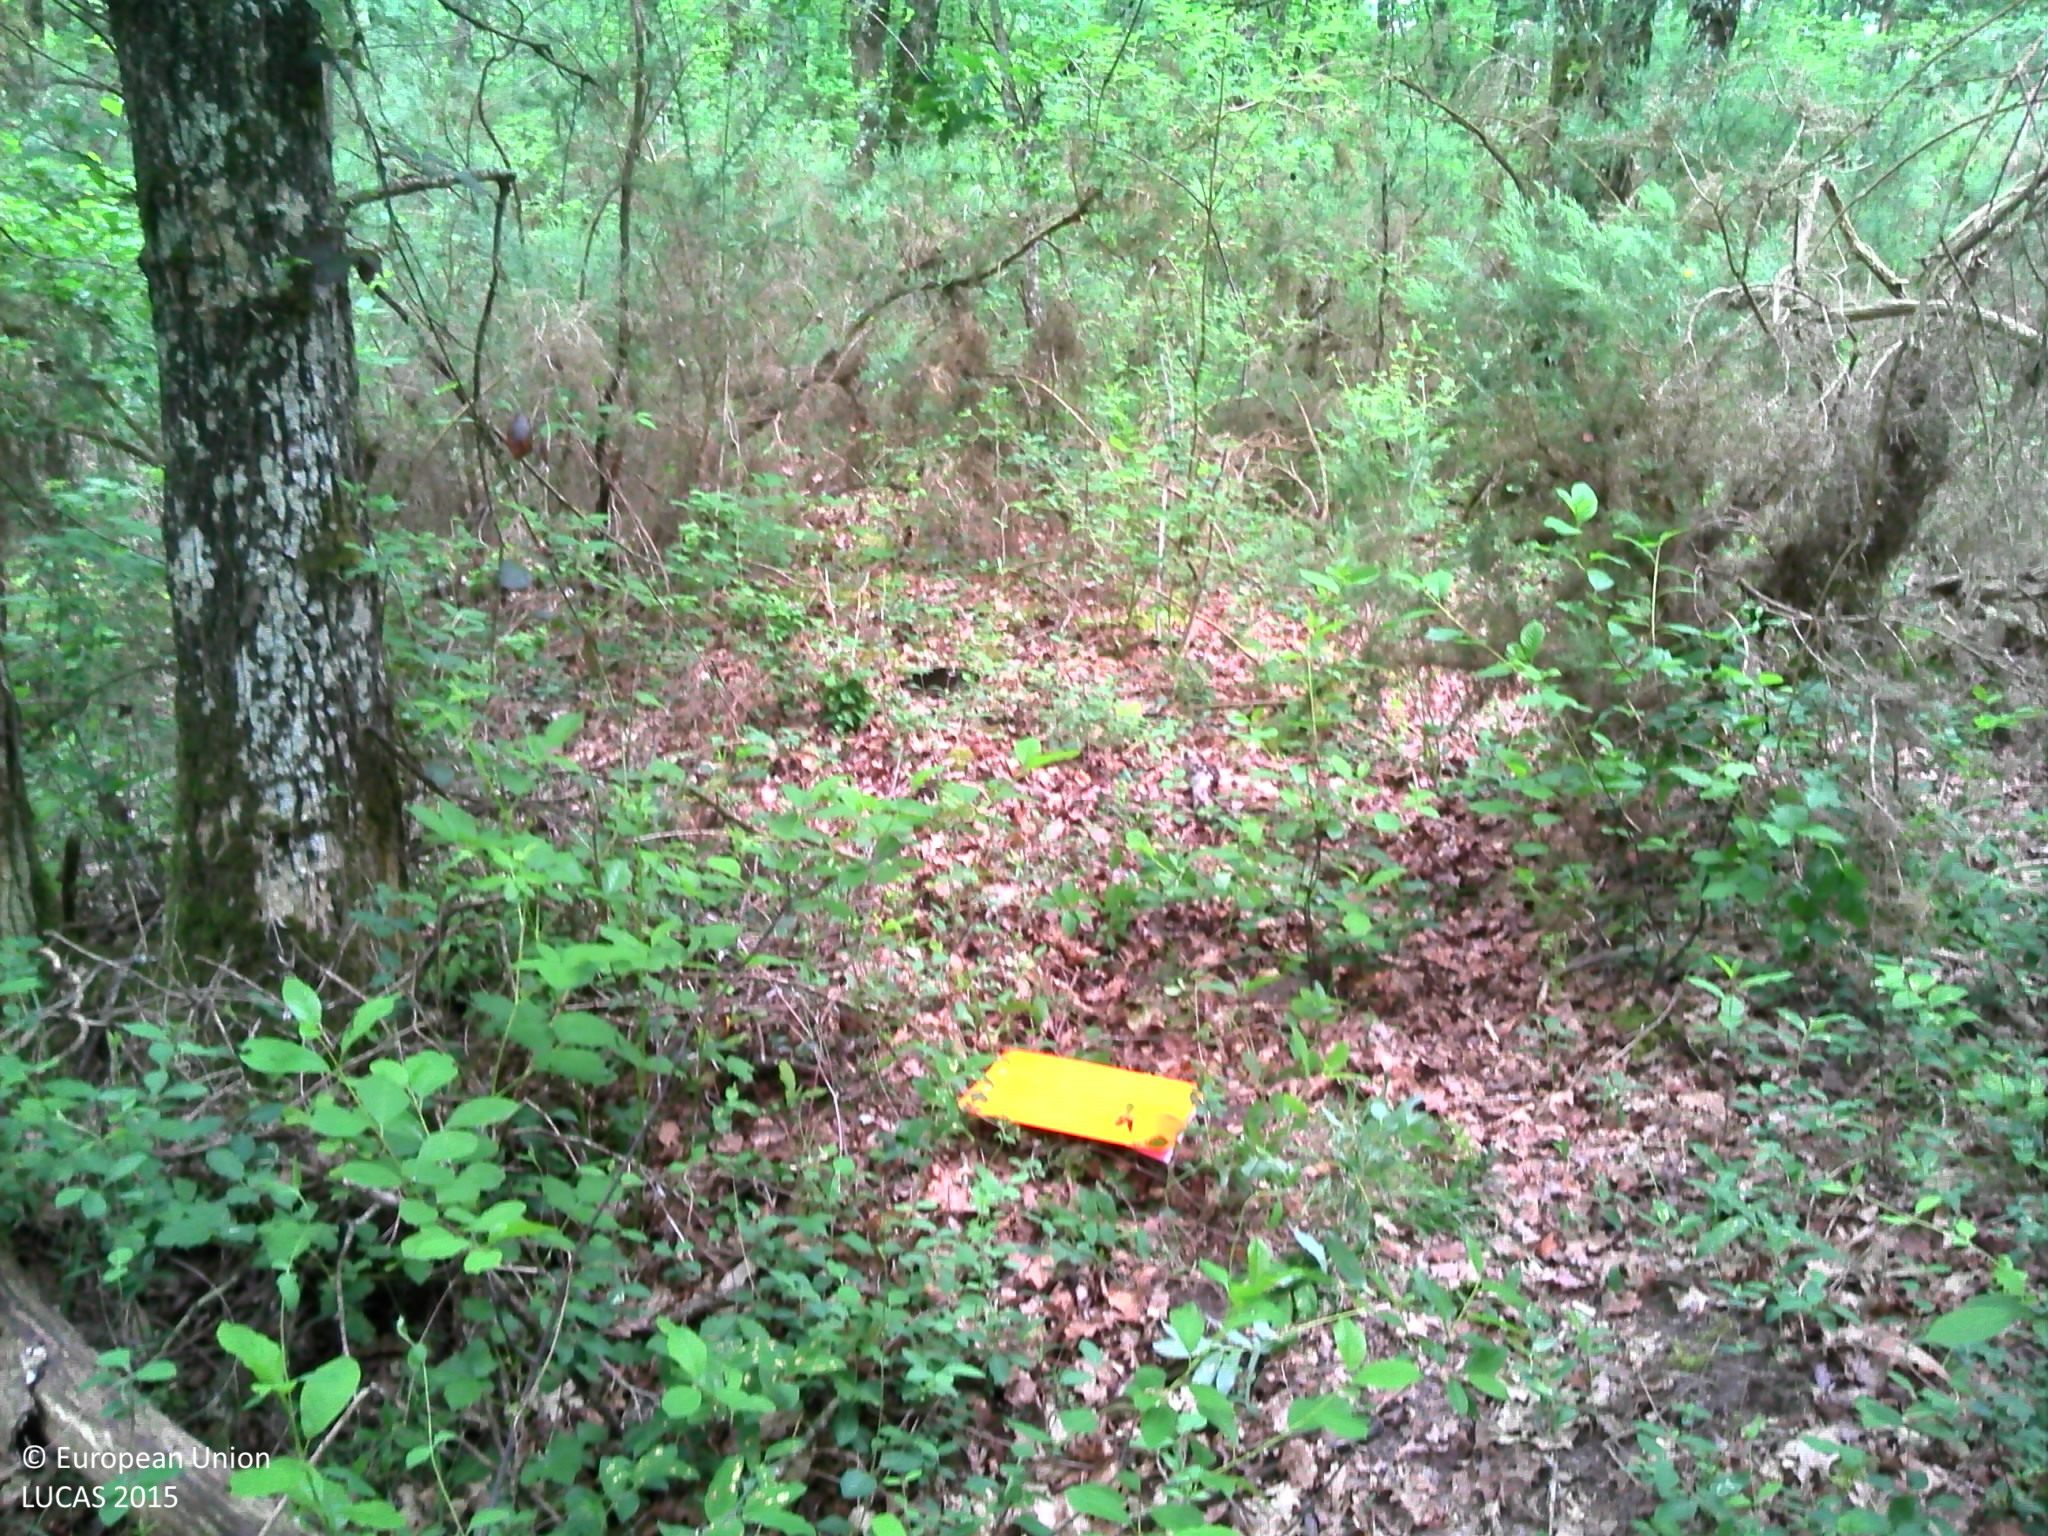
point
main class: Woodland
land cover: Broadleaved woodland
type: acidophilous oak and oak-birch forest
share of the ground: > 75 %
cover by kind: broadleaved forest trees 80 %, unconsolidated bare surface 10 %, shrubs 5 %, herbaceous plants 5 %
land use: Forestry
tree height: > 5 m
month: May
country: FR
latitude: 47.1043
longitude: 0.0807
